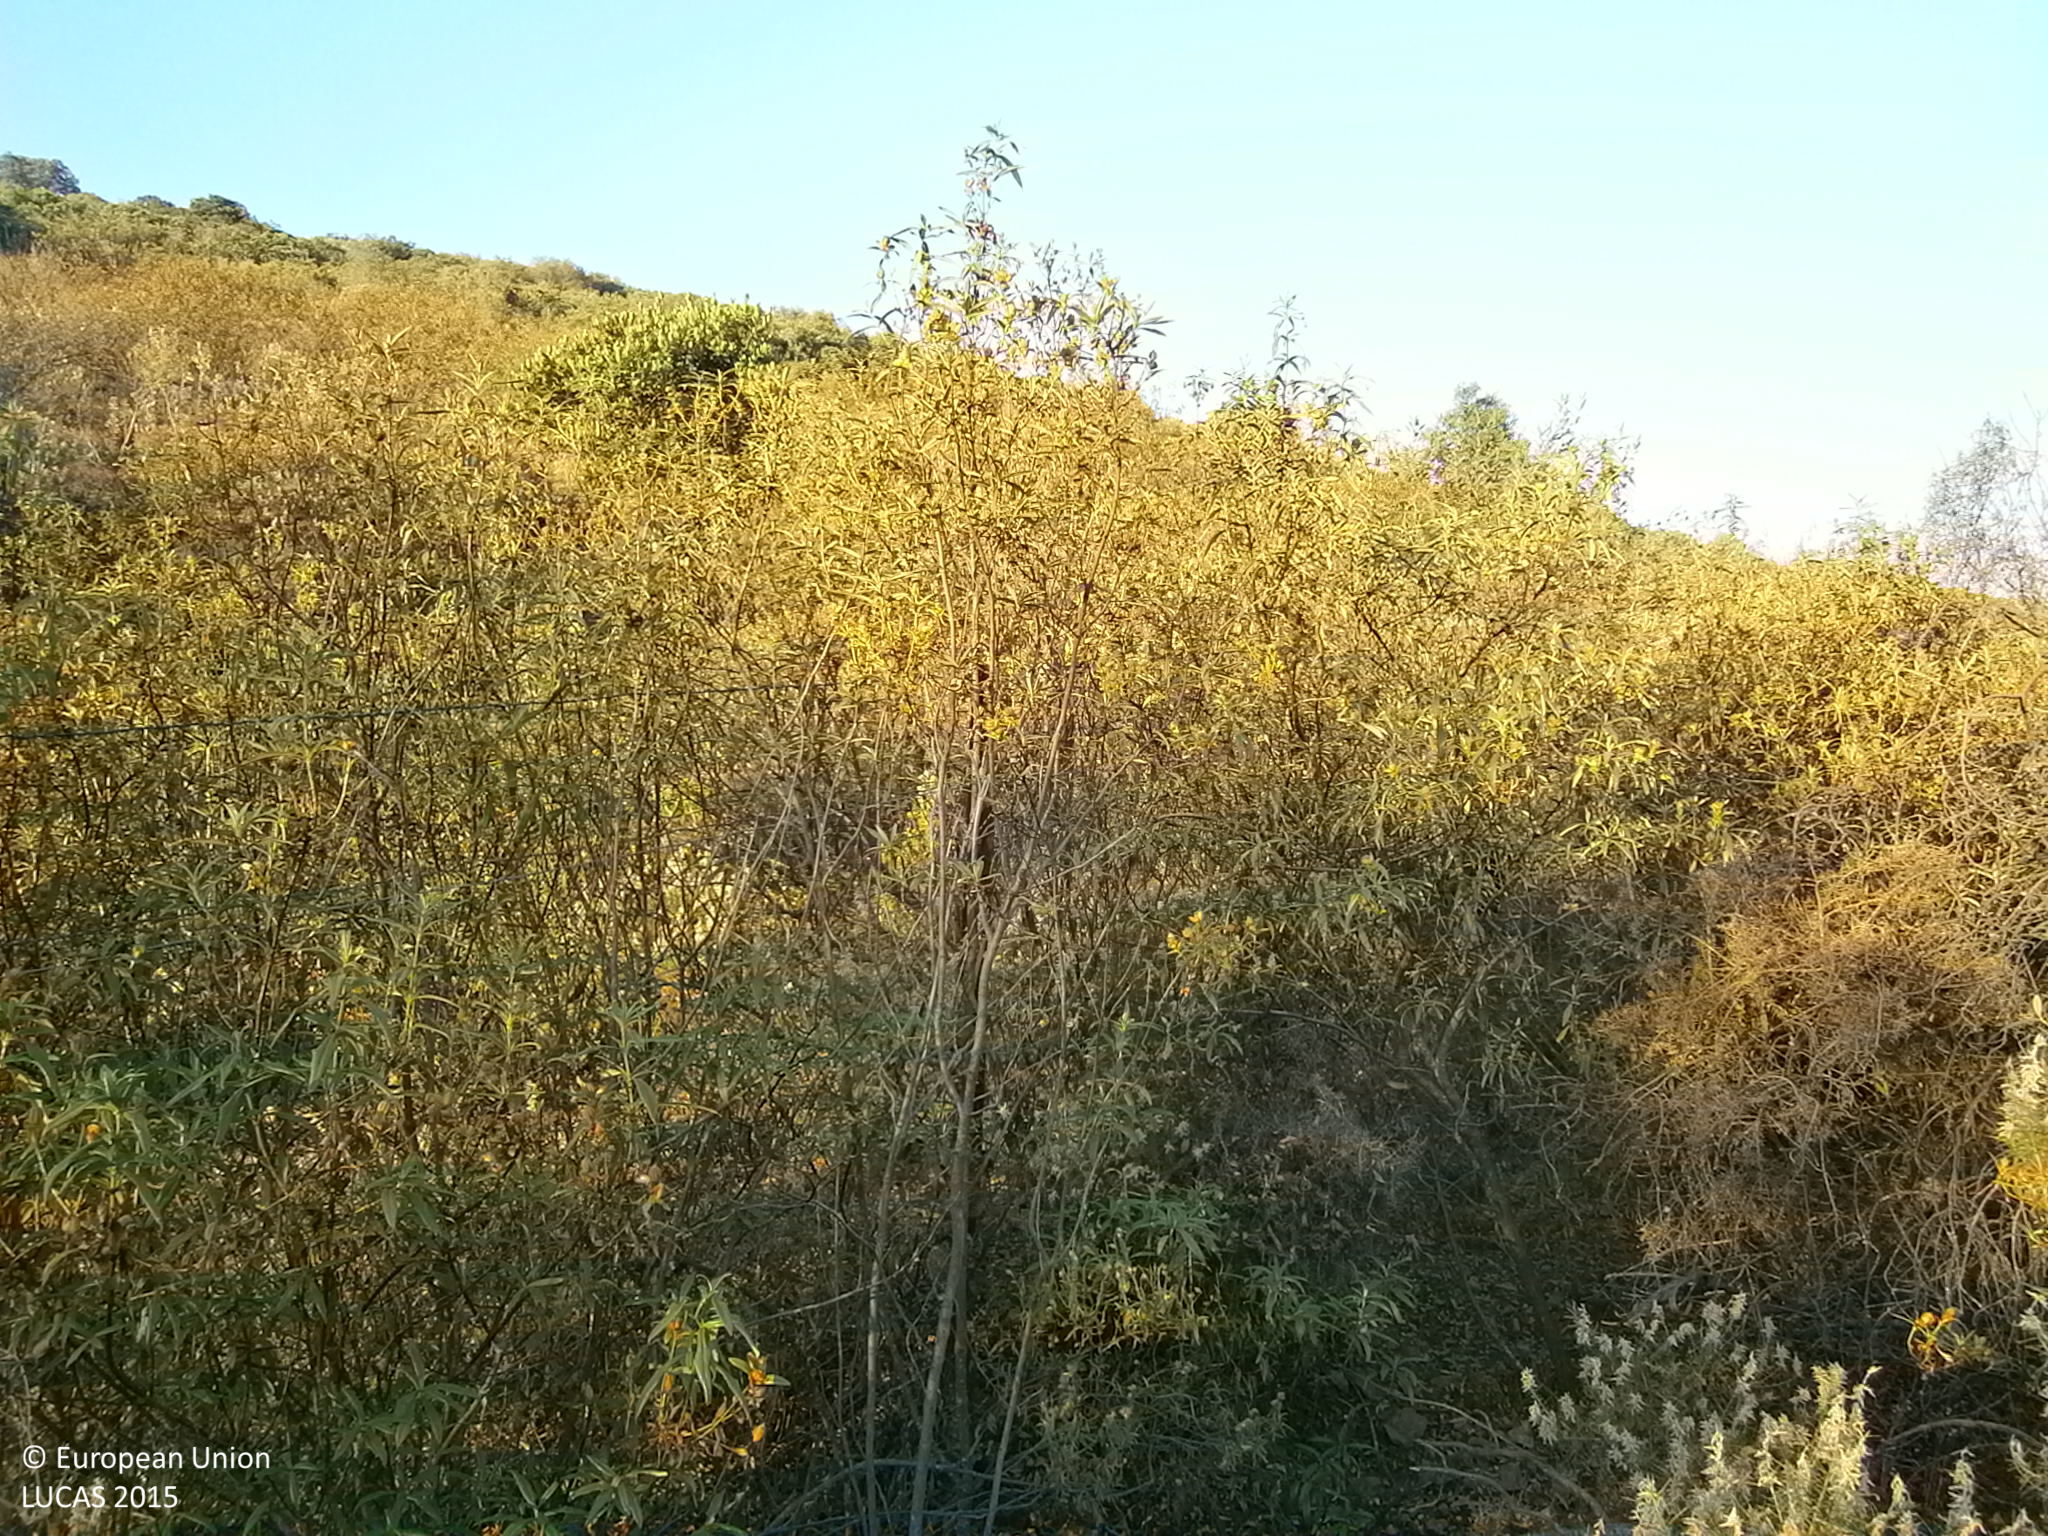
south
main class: Shrubland
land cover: Shrubland with sparse tree cover
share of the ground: > 75 %
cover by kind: shrubs 95 %, broadleaved forest trees 5 %
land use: Forestry
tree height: > 5 m
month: June
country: ES
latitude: 38.5625
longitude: -6.6171
